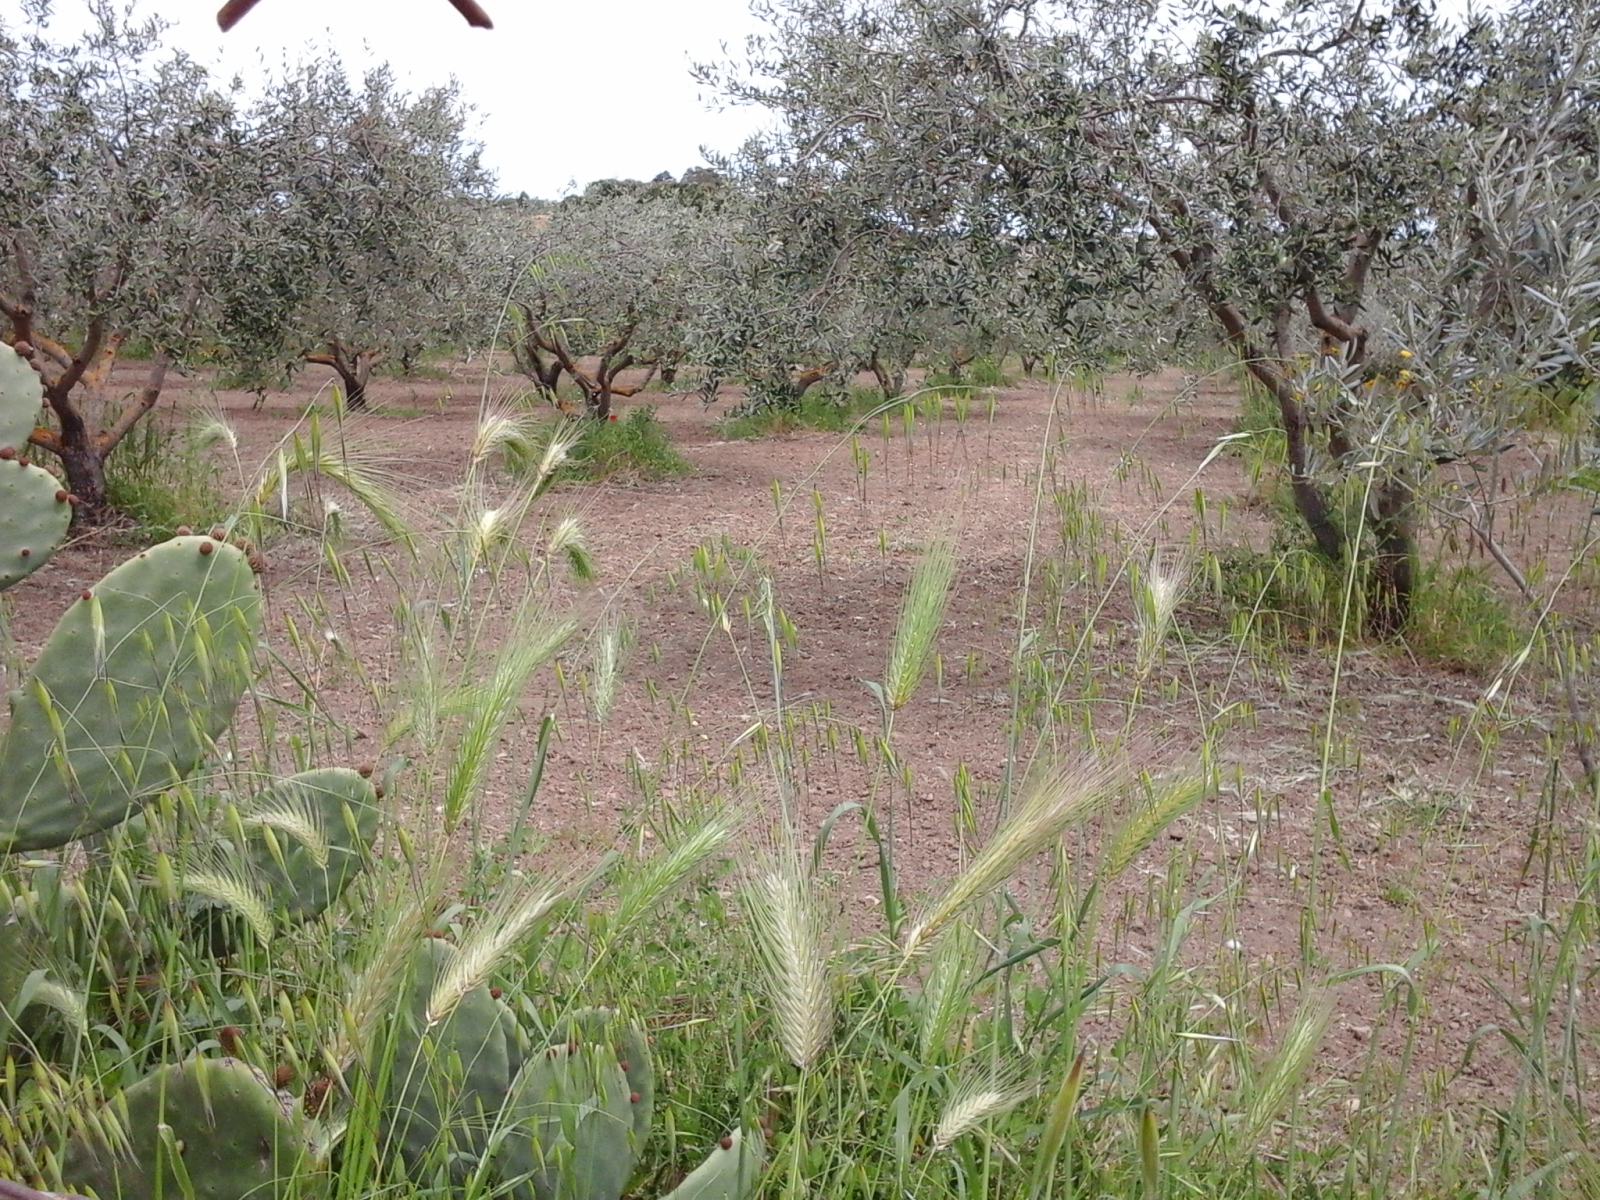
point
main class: Cropland
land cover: Olive groves
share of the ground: 50 - 75 %
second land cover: Other bare soil
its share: > 75 %
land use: Agriculture (excluding fallow land and kitchen gardens)
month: May
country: IT
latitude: 37.4192
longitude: 14.1831
